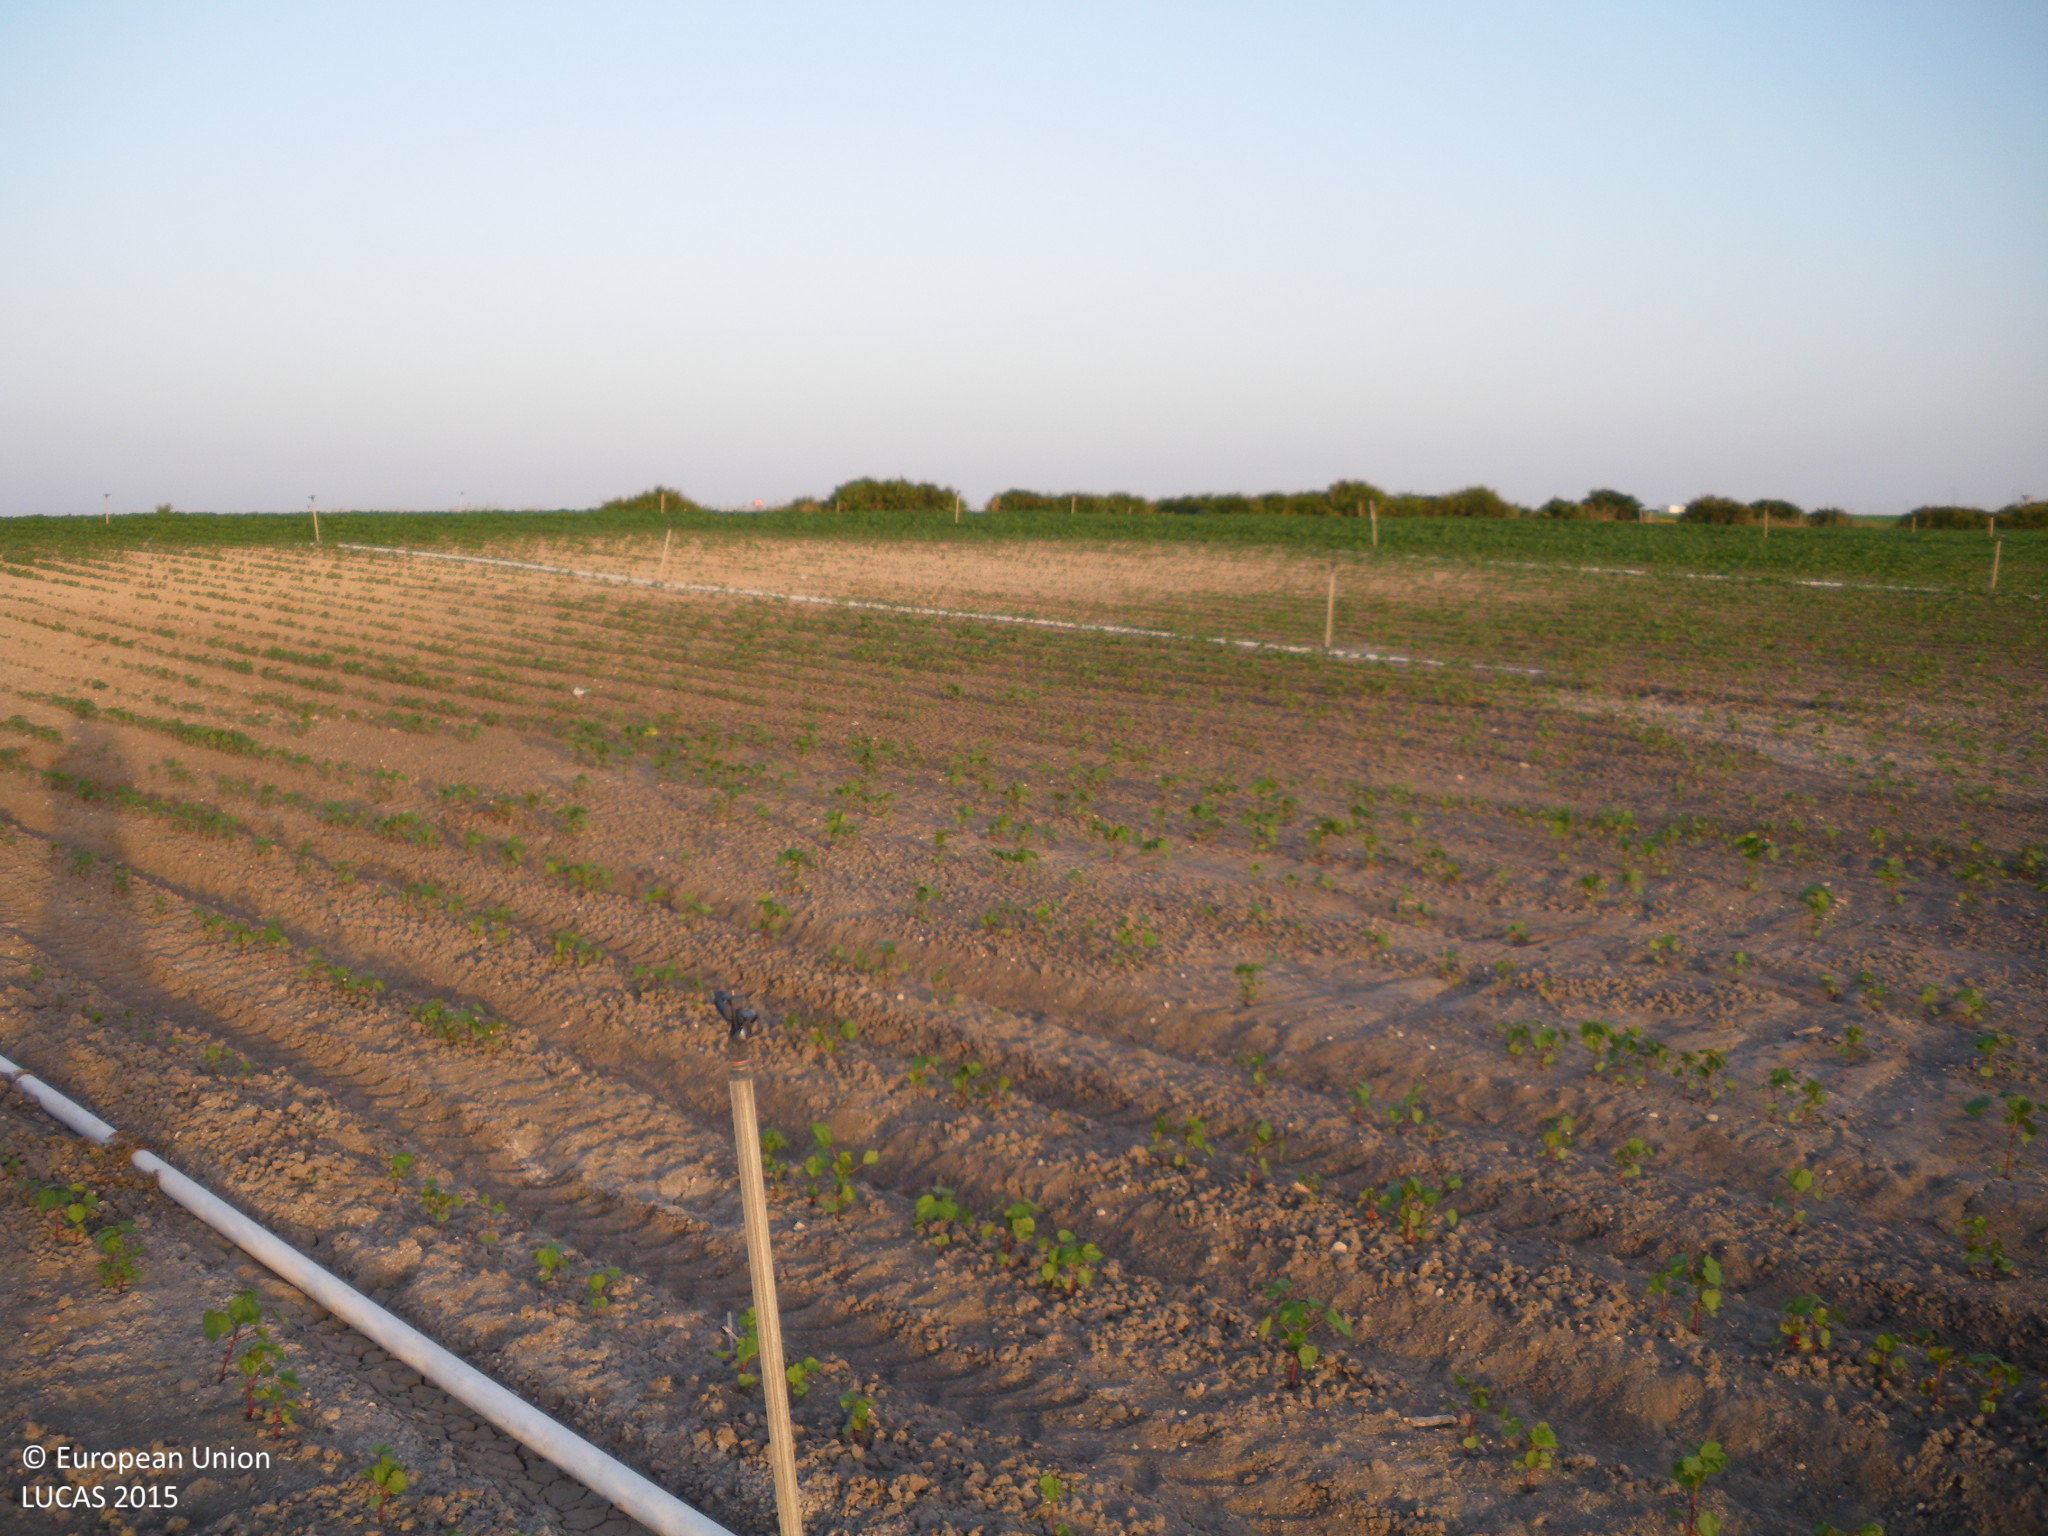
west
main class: Cropland
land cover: Cotton
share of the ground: < 10 %
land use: Agriculture (excluding fallow land and kitchen gardens)
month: June
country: ES
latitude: 36.6543
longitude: -6.2451
